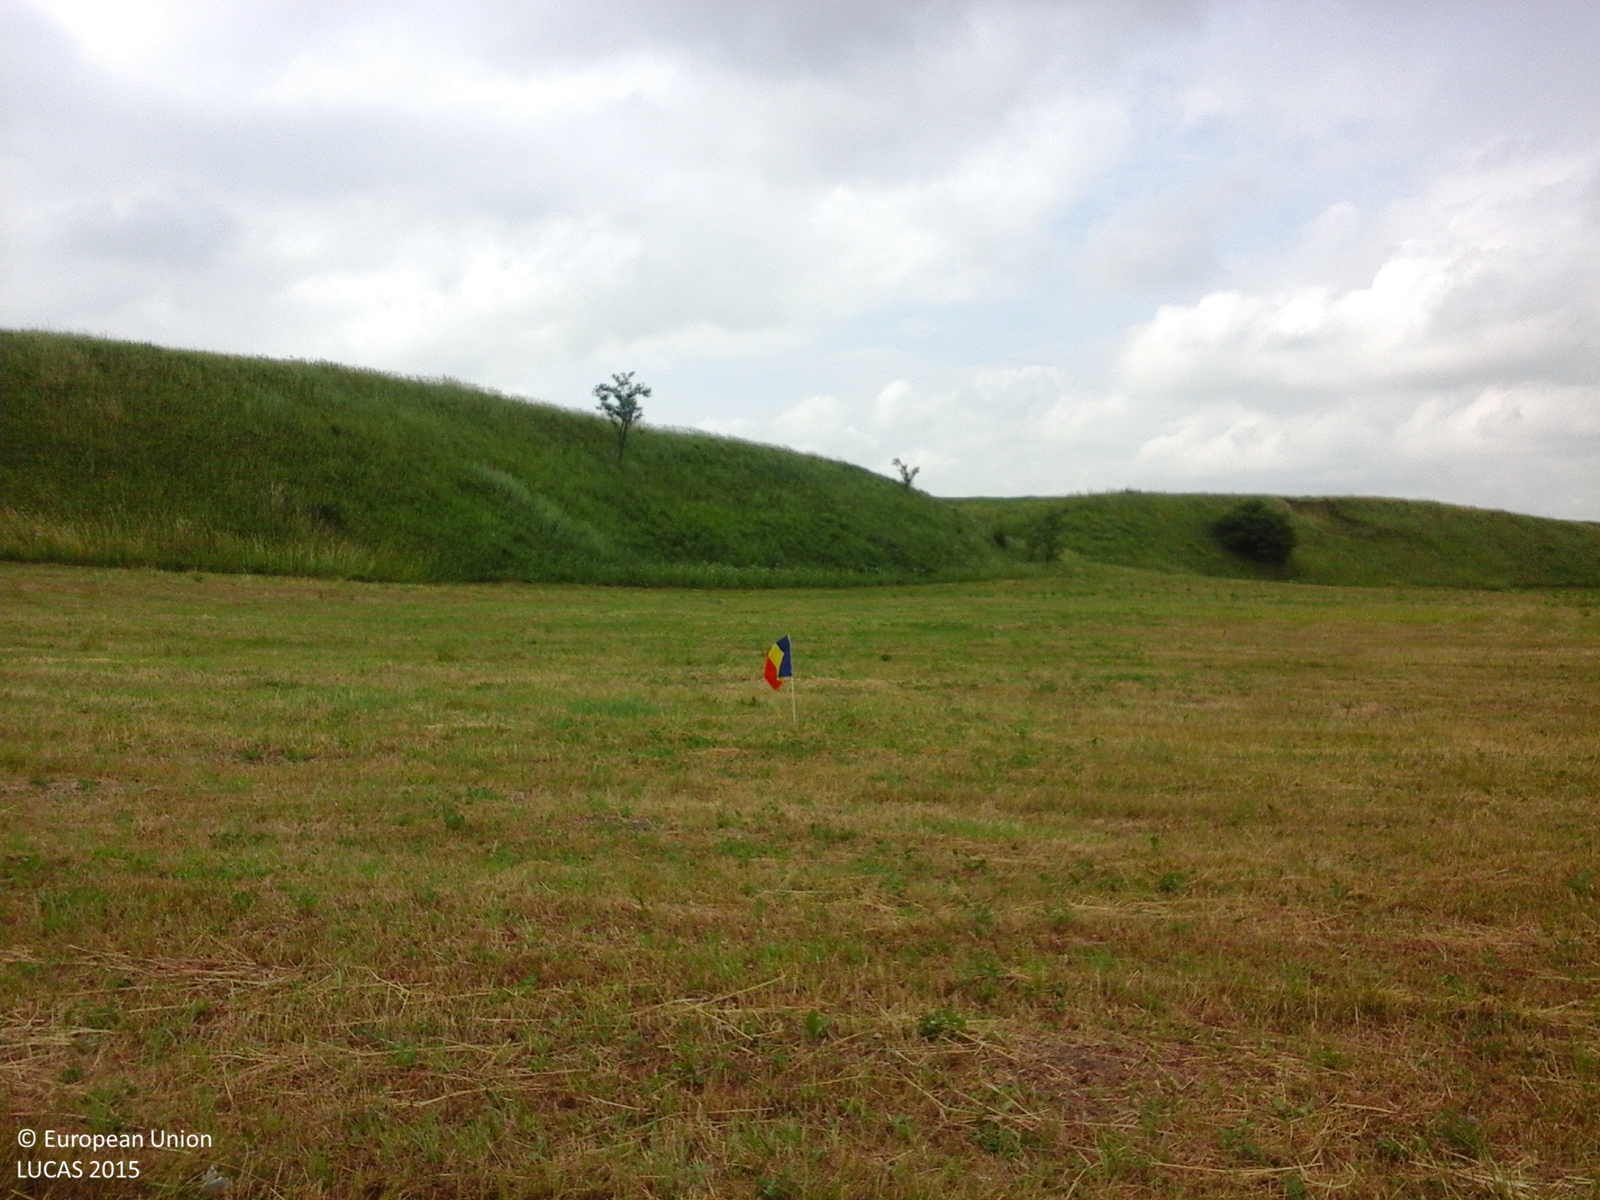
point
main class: Cropland
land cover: Other leguminous and mixtures for fodder
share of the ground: > 75 %
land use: Agriculture (excluding fallow land and kitchen gardens)
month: June
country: RO
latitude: 47.3627
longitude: 26.6838
